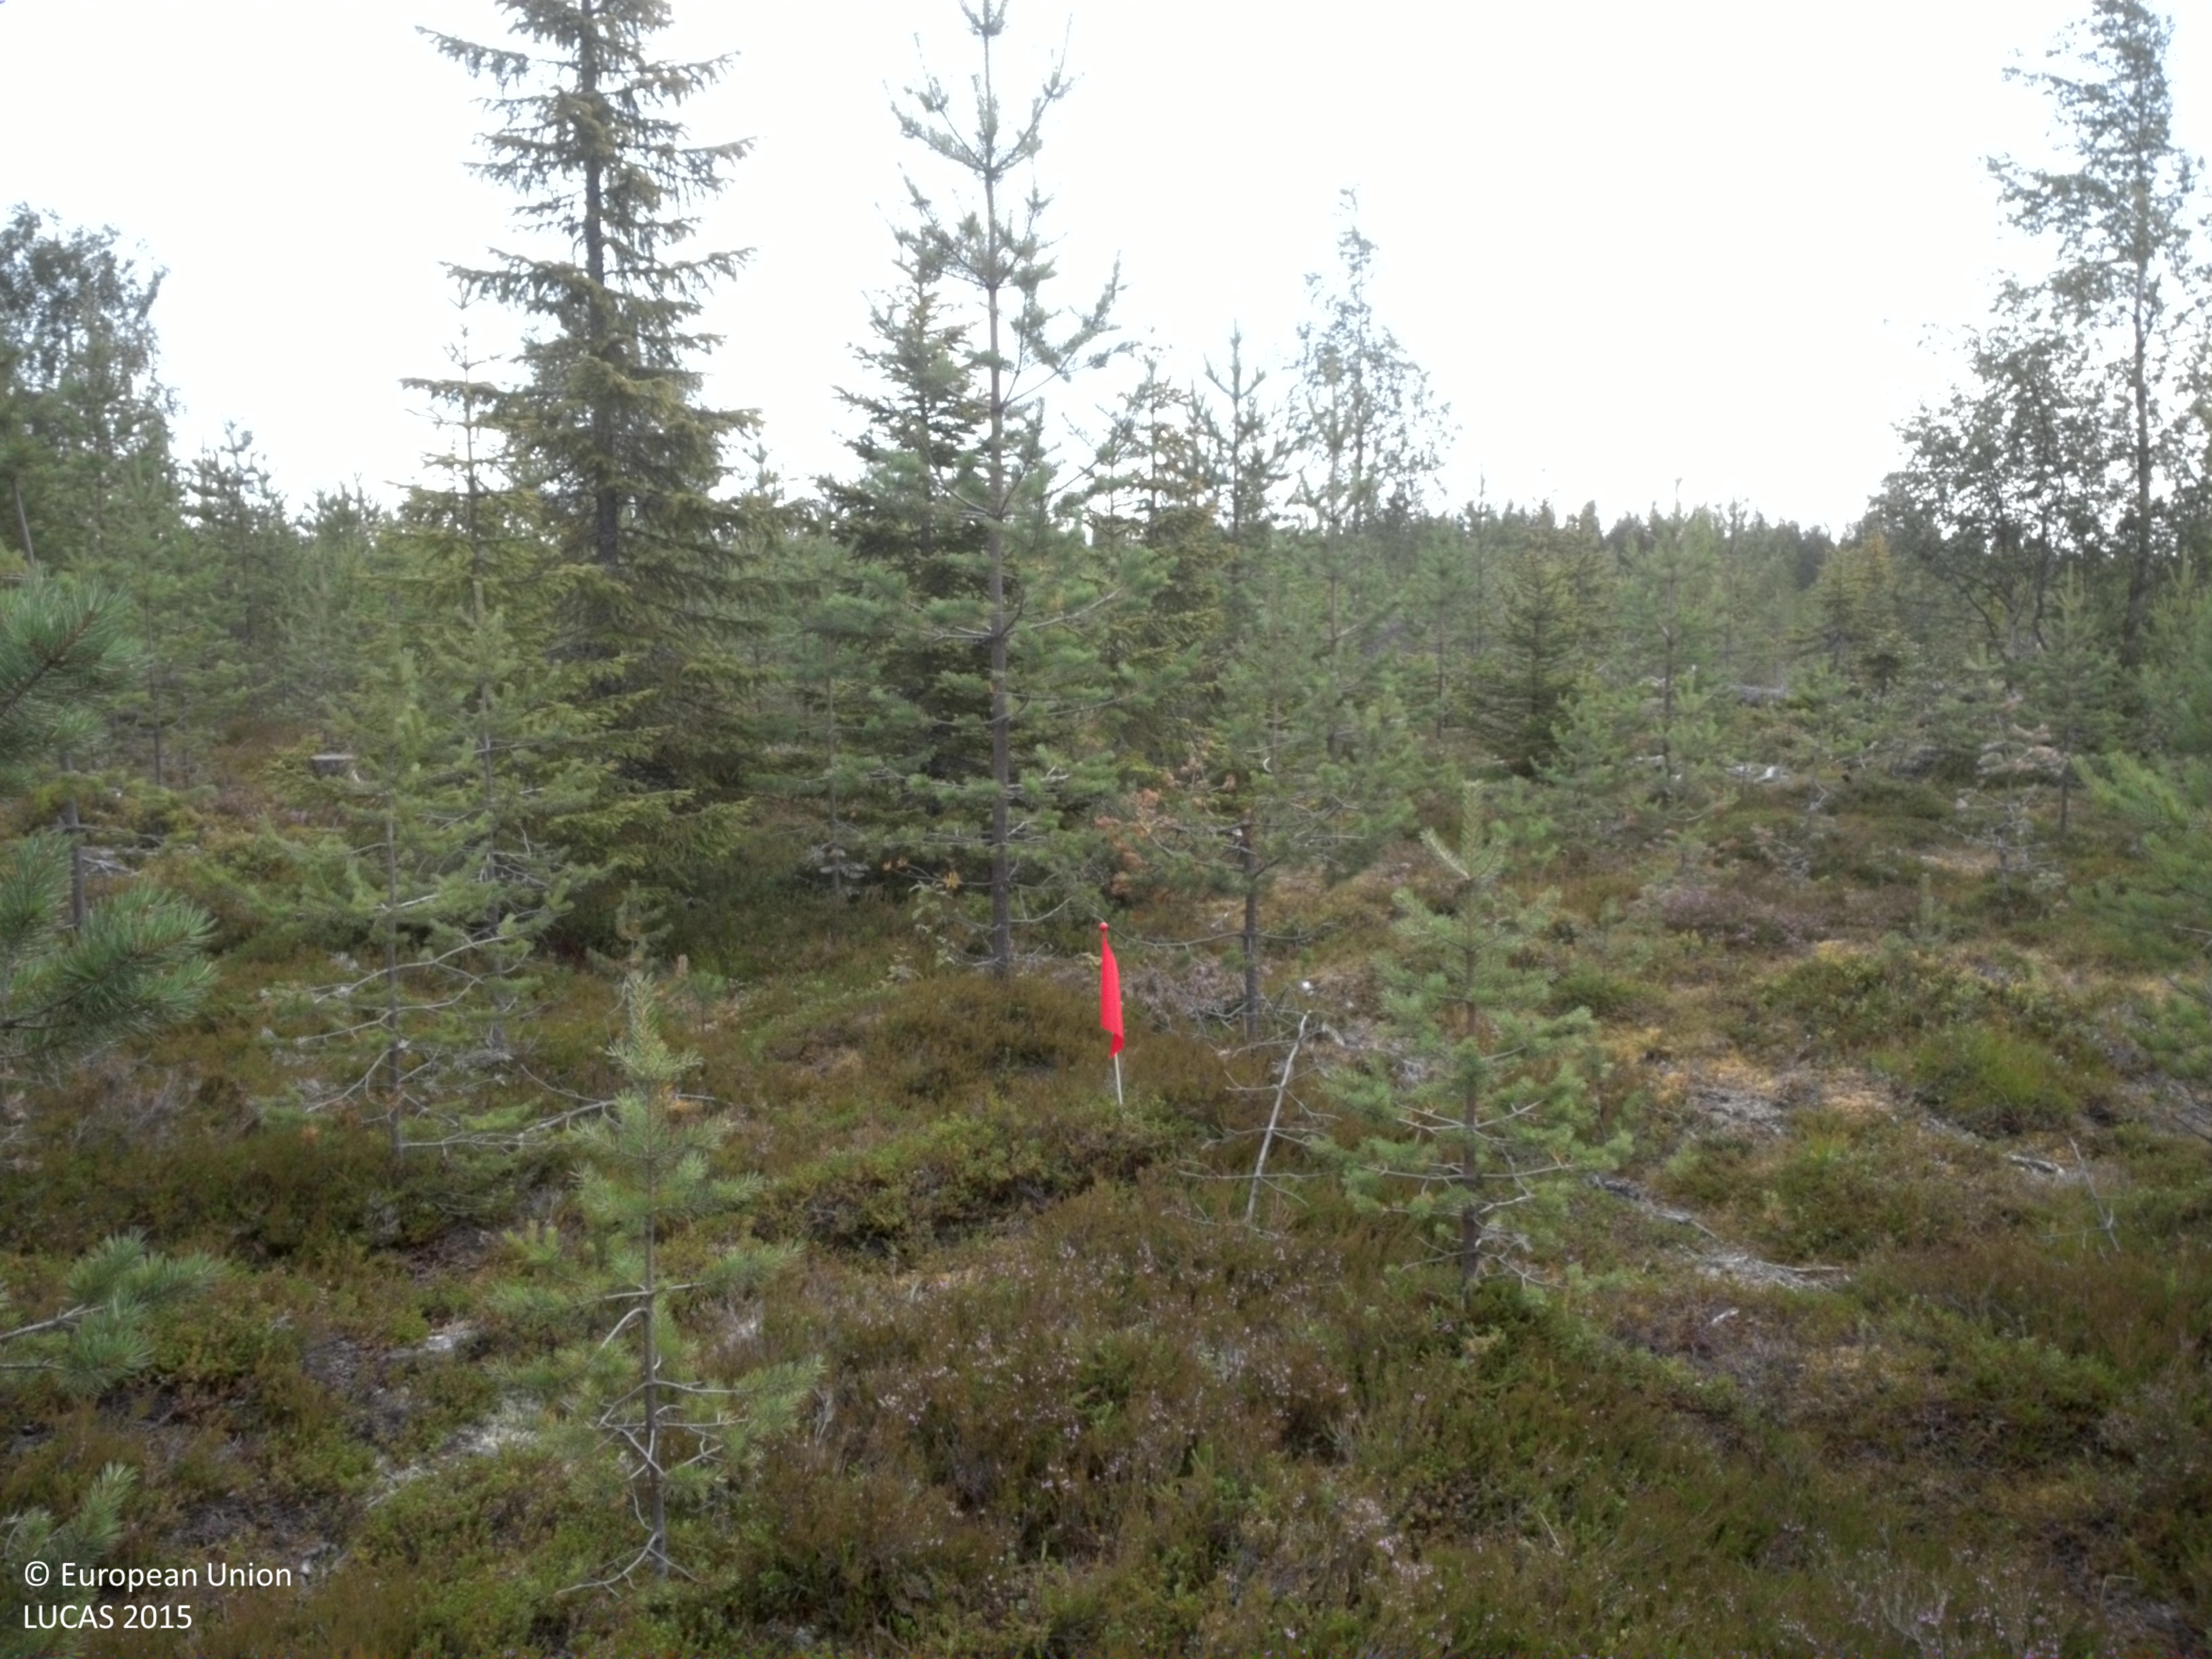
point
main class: Woodland
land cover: Other coniferous woodland
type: boreal forest
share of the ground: 50 - 75 %
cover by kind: coniferous forest trees 50 %, shrubs 35 %, lichens and mosses 10 %, broadleaved forest trees 5 %
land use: Forestry
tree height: > 5 m
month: August
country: SE
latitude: 64.5833
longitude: 20.1437
